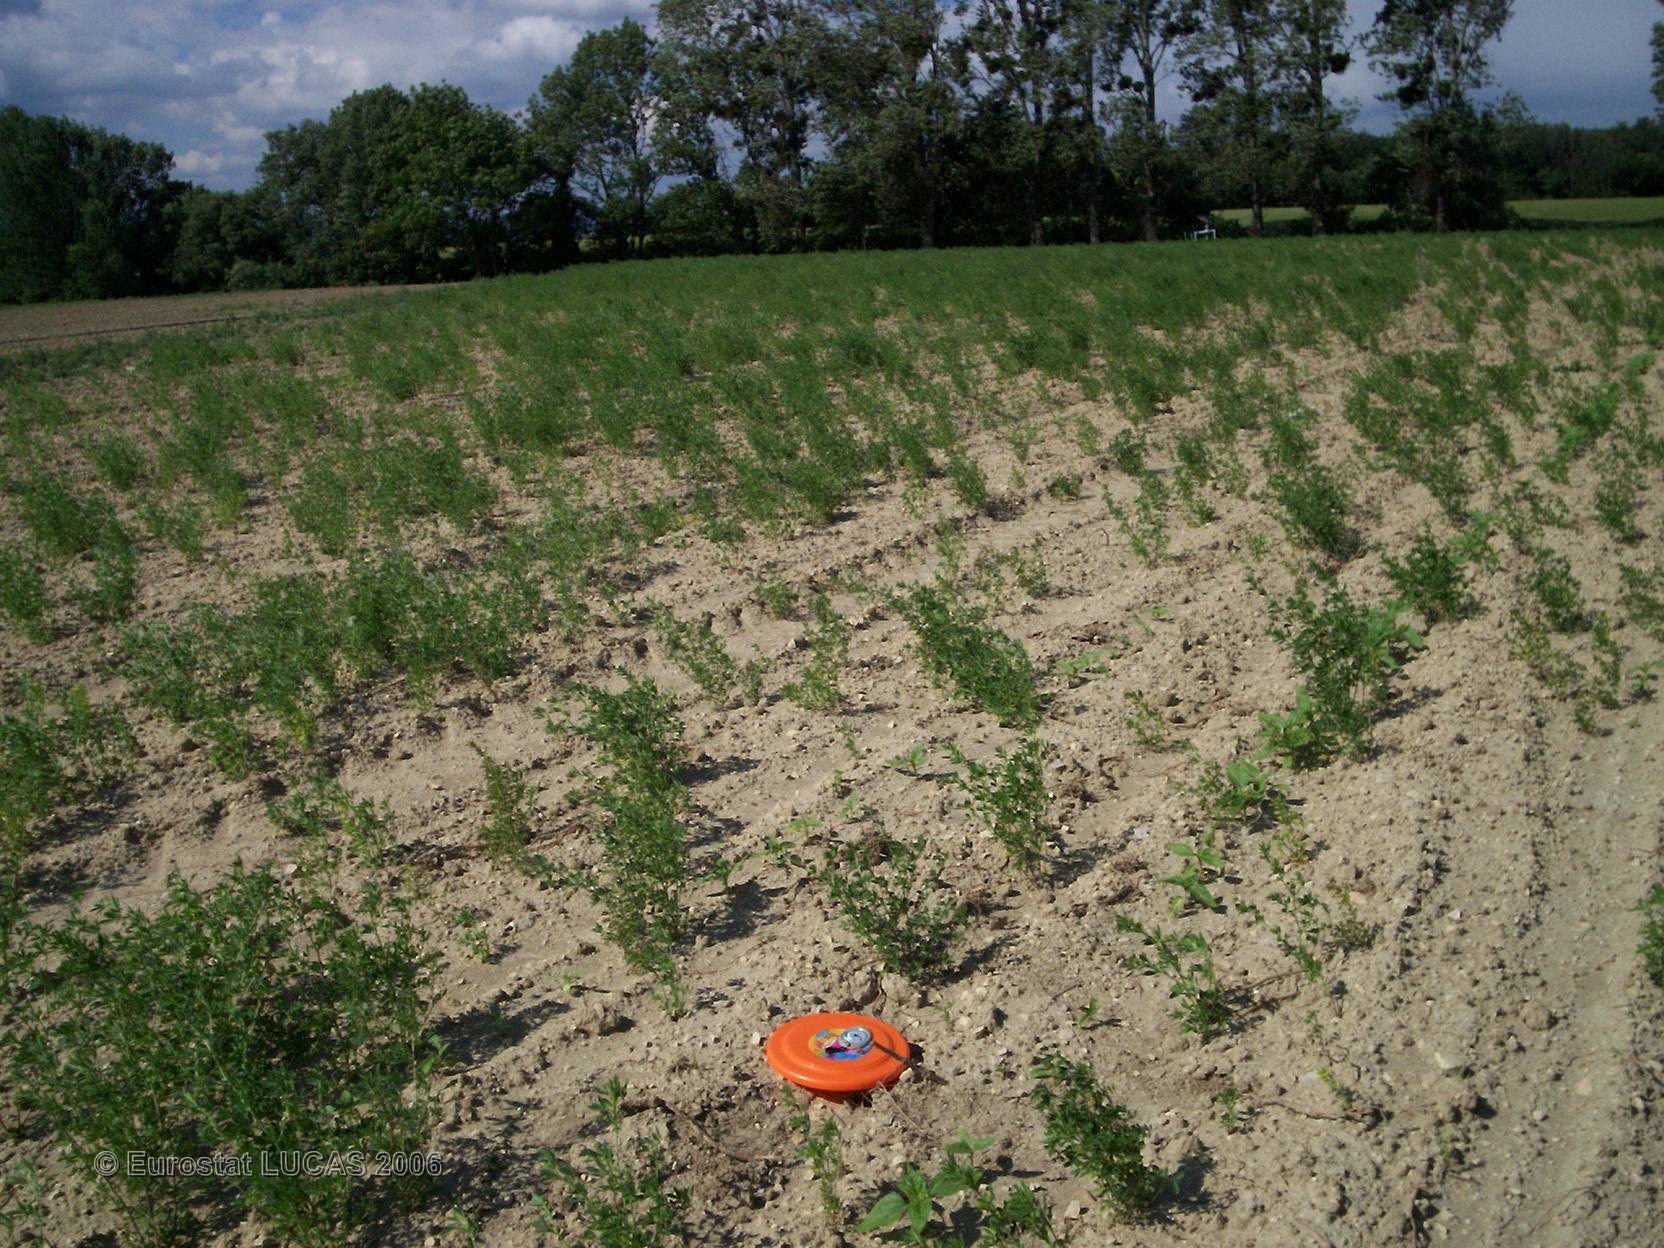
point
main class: Cropland
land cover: Sunflower
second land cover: Lucerne
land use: Agriculture (excluding fallow land and kitchen gardens)
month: May
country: FR
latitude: 44.6215
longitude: 4.8771
